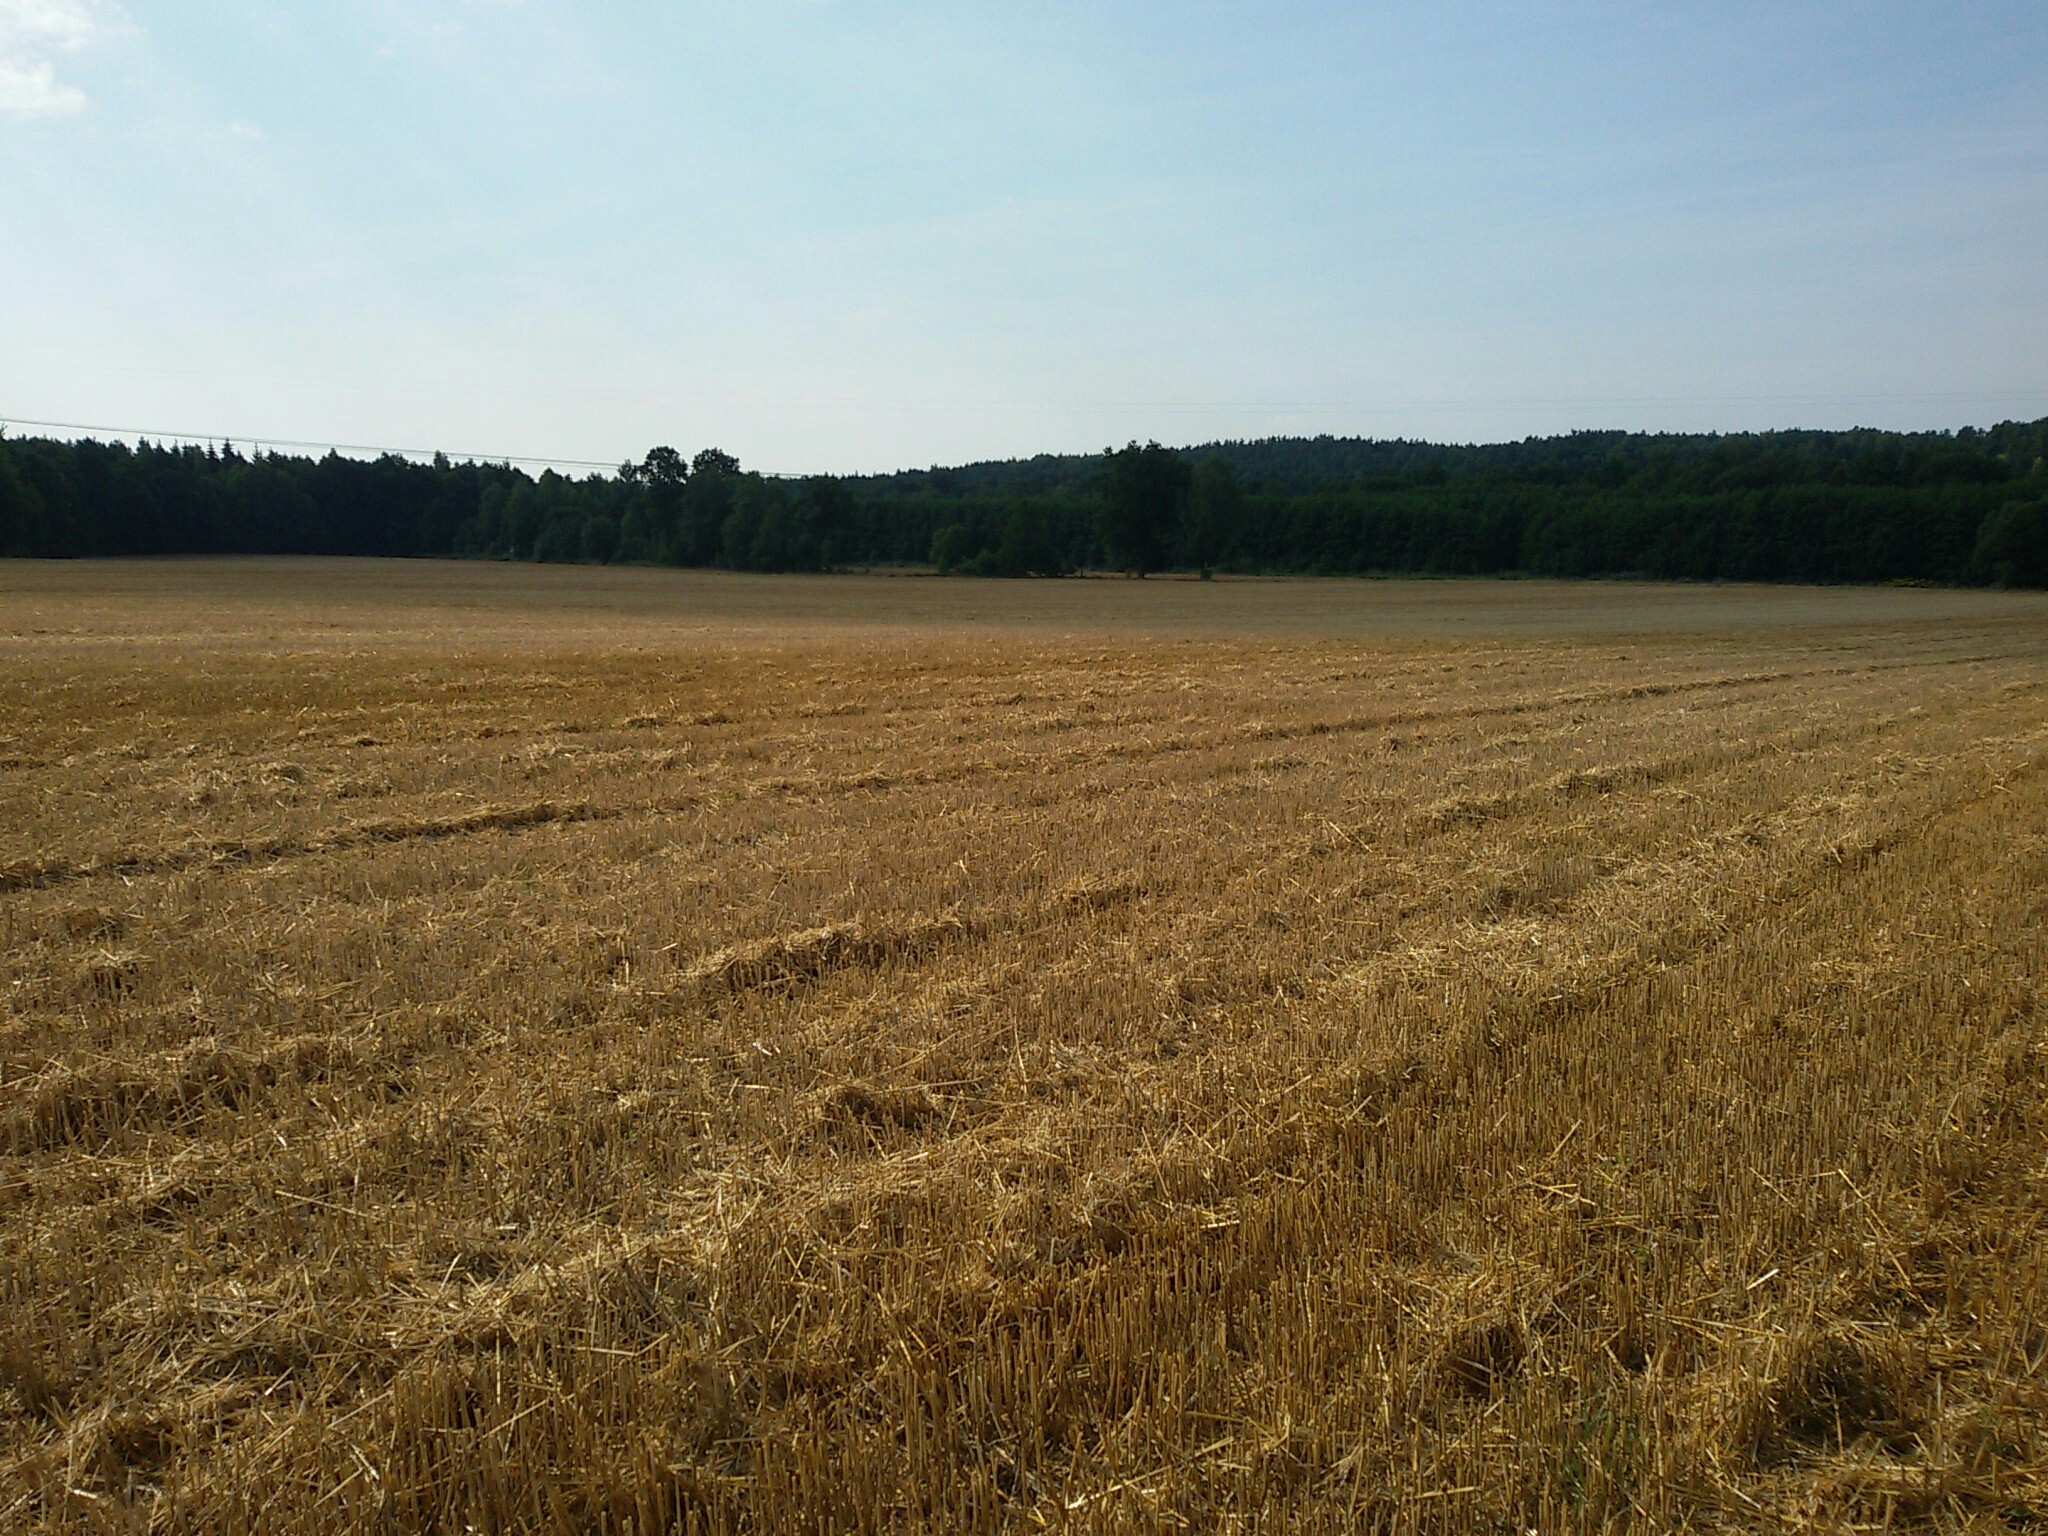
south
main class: Cropland
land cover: Oats
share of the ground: > 75 %
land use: Agriculture (excluding fallow land and kitchen gardens)
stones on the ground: < 10 %
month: August
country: PL
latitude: 51.1519
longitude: 15.4798
